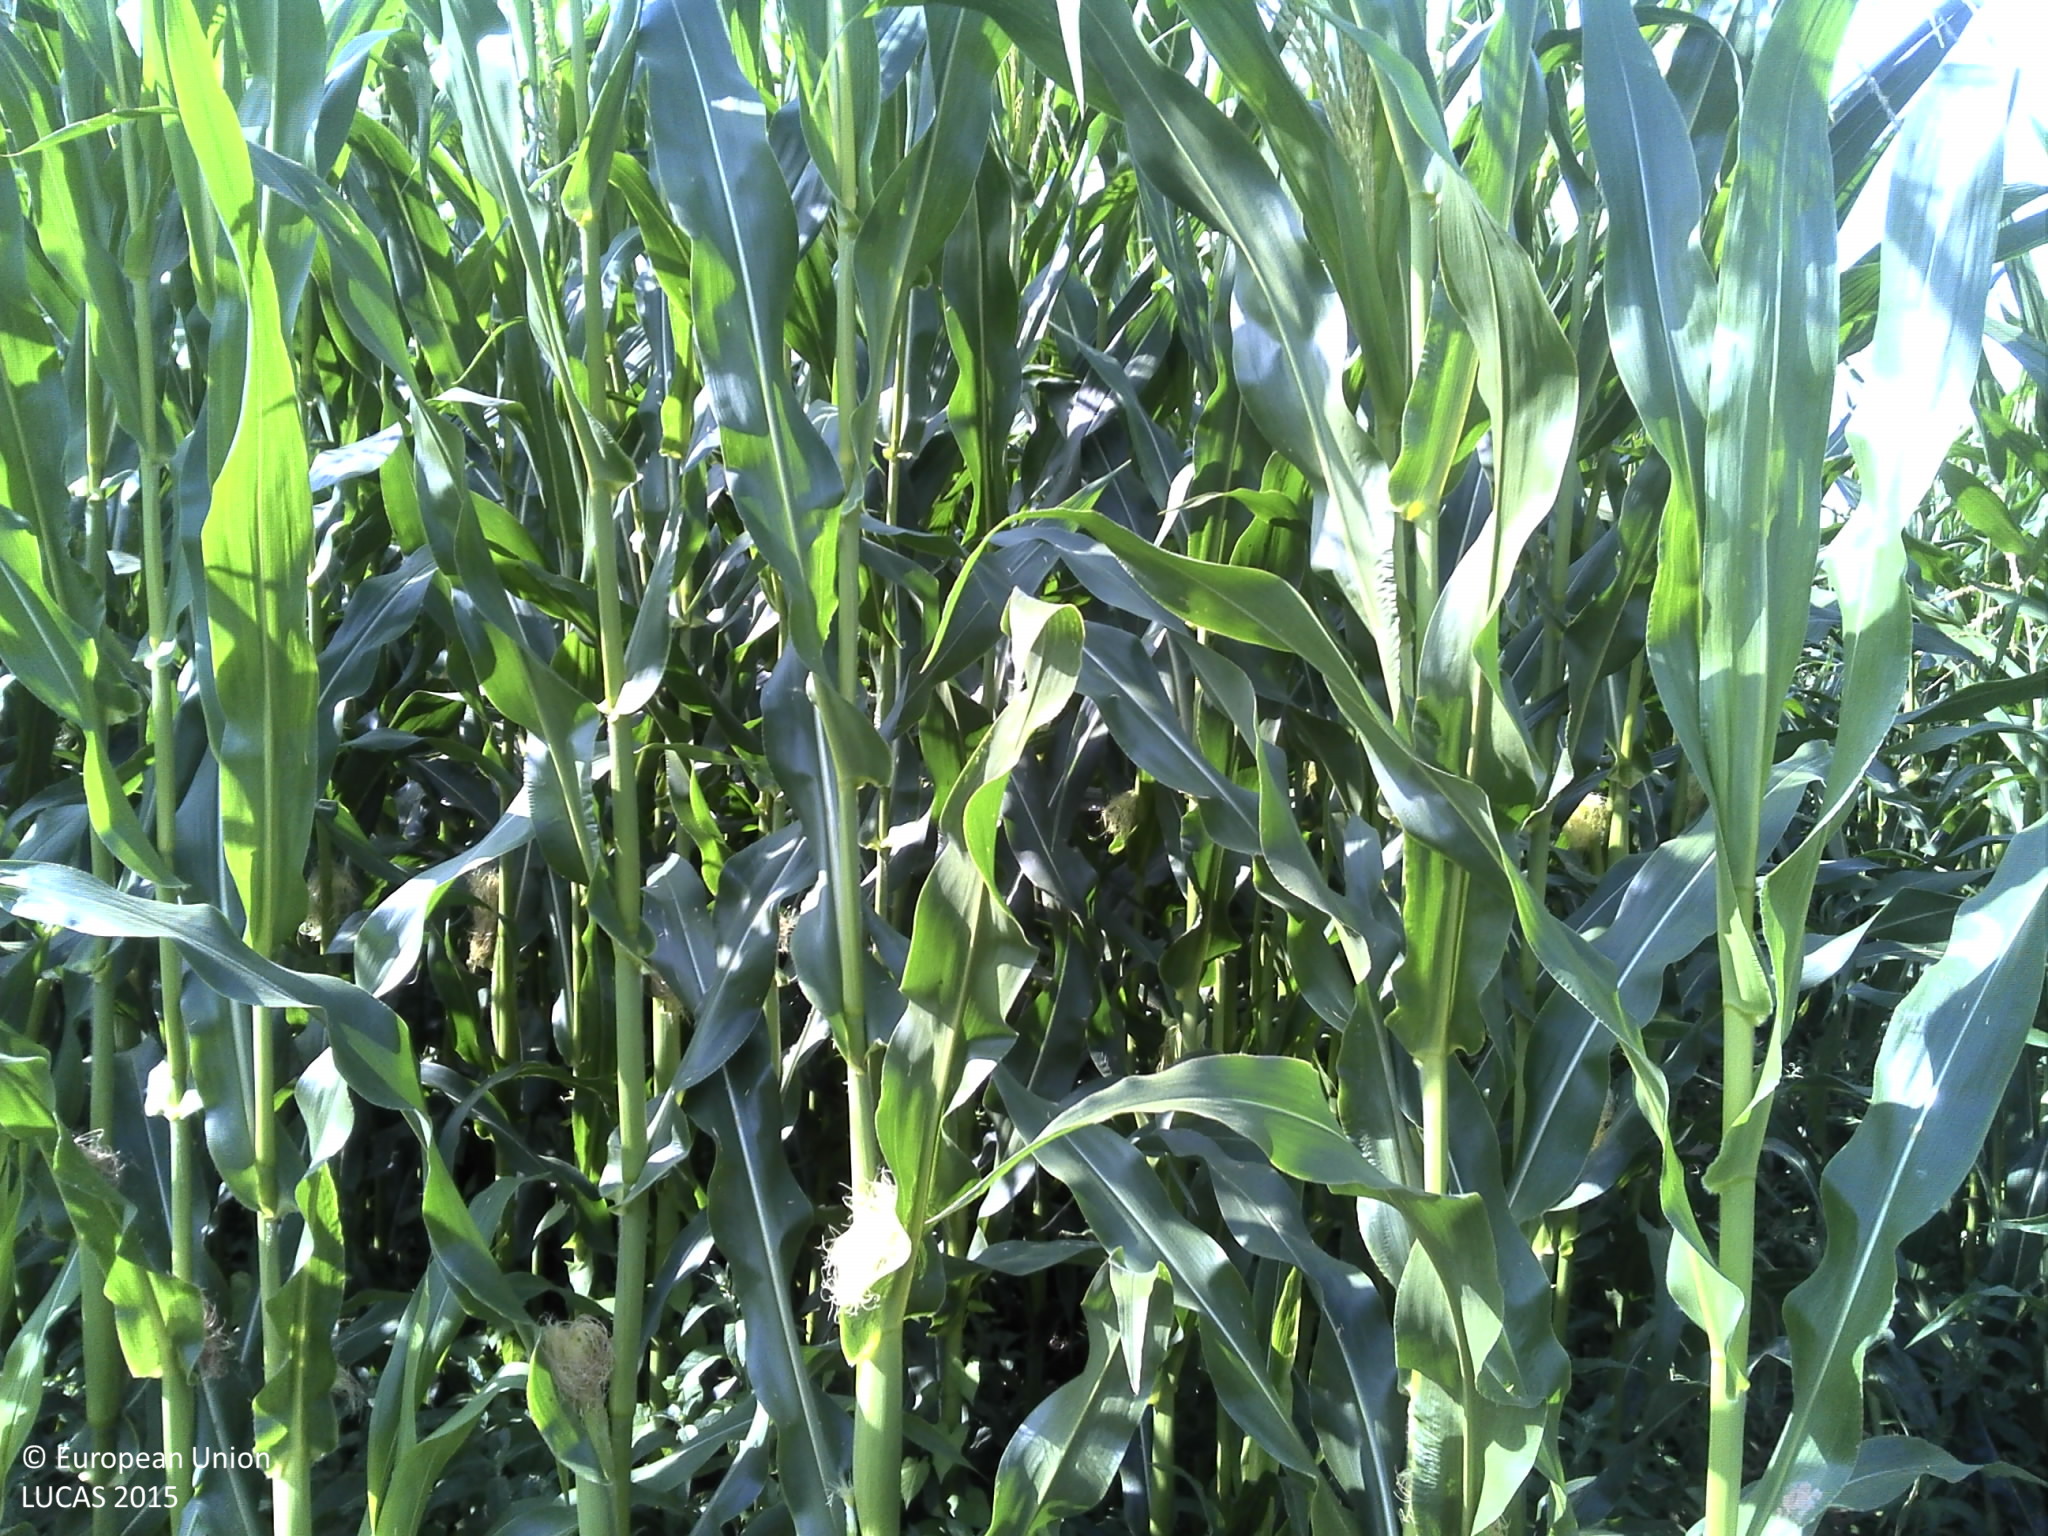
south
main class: Cropland
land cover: Maize
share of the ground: > 75 %
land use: Agriculture (excluding fallow land and kitchen gardens)
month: July
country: FR
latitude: 45.8708
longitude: 3.3141
